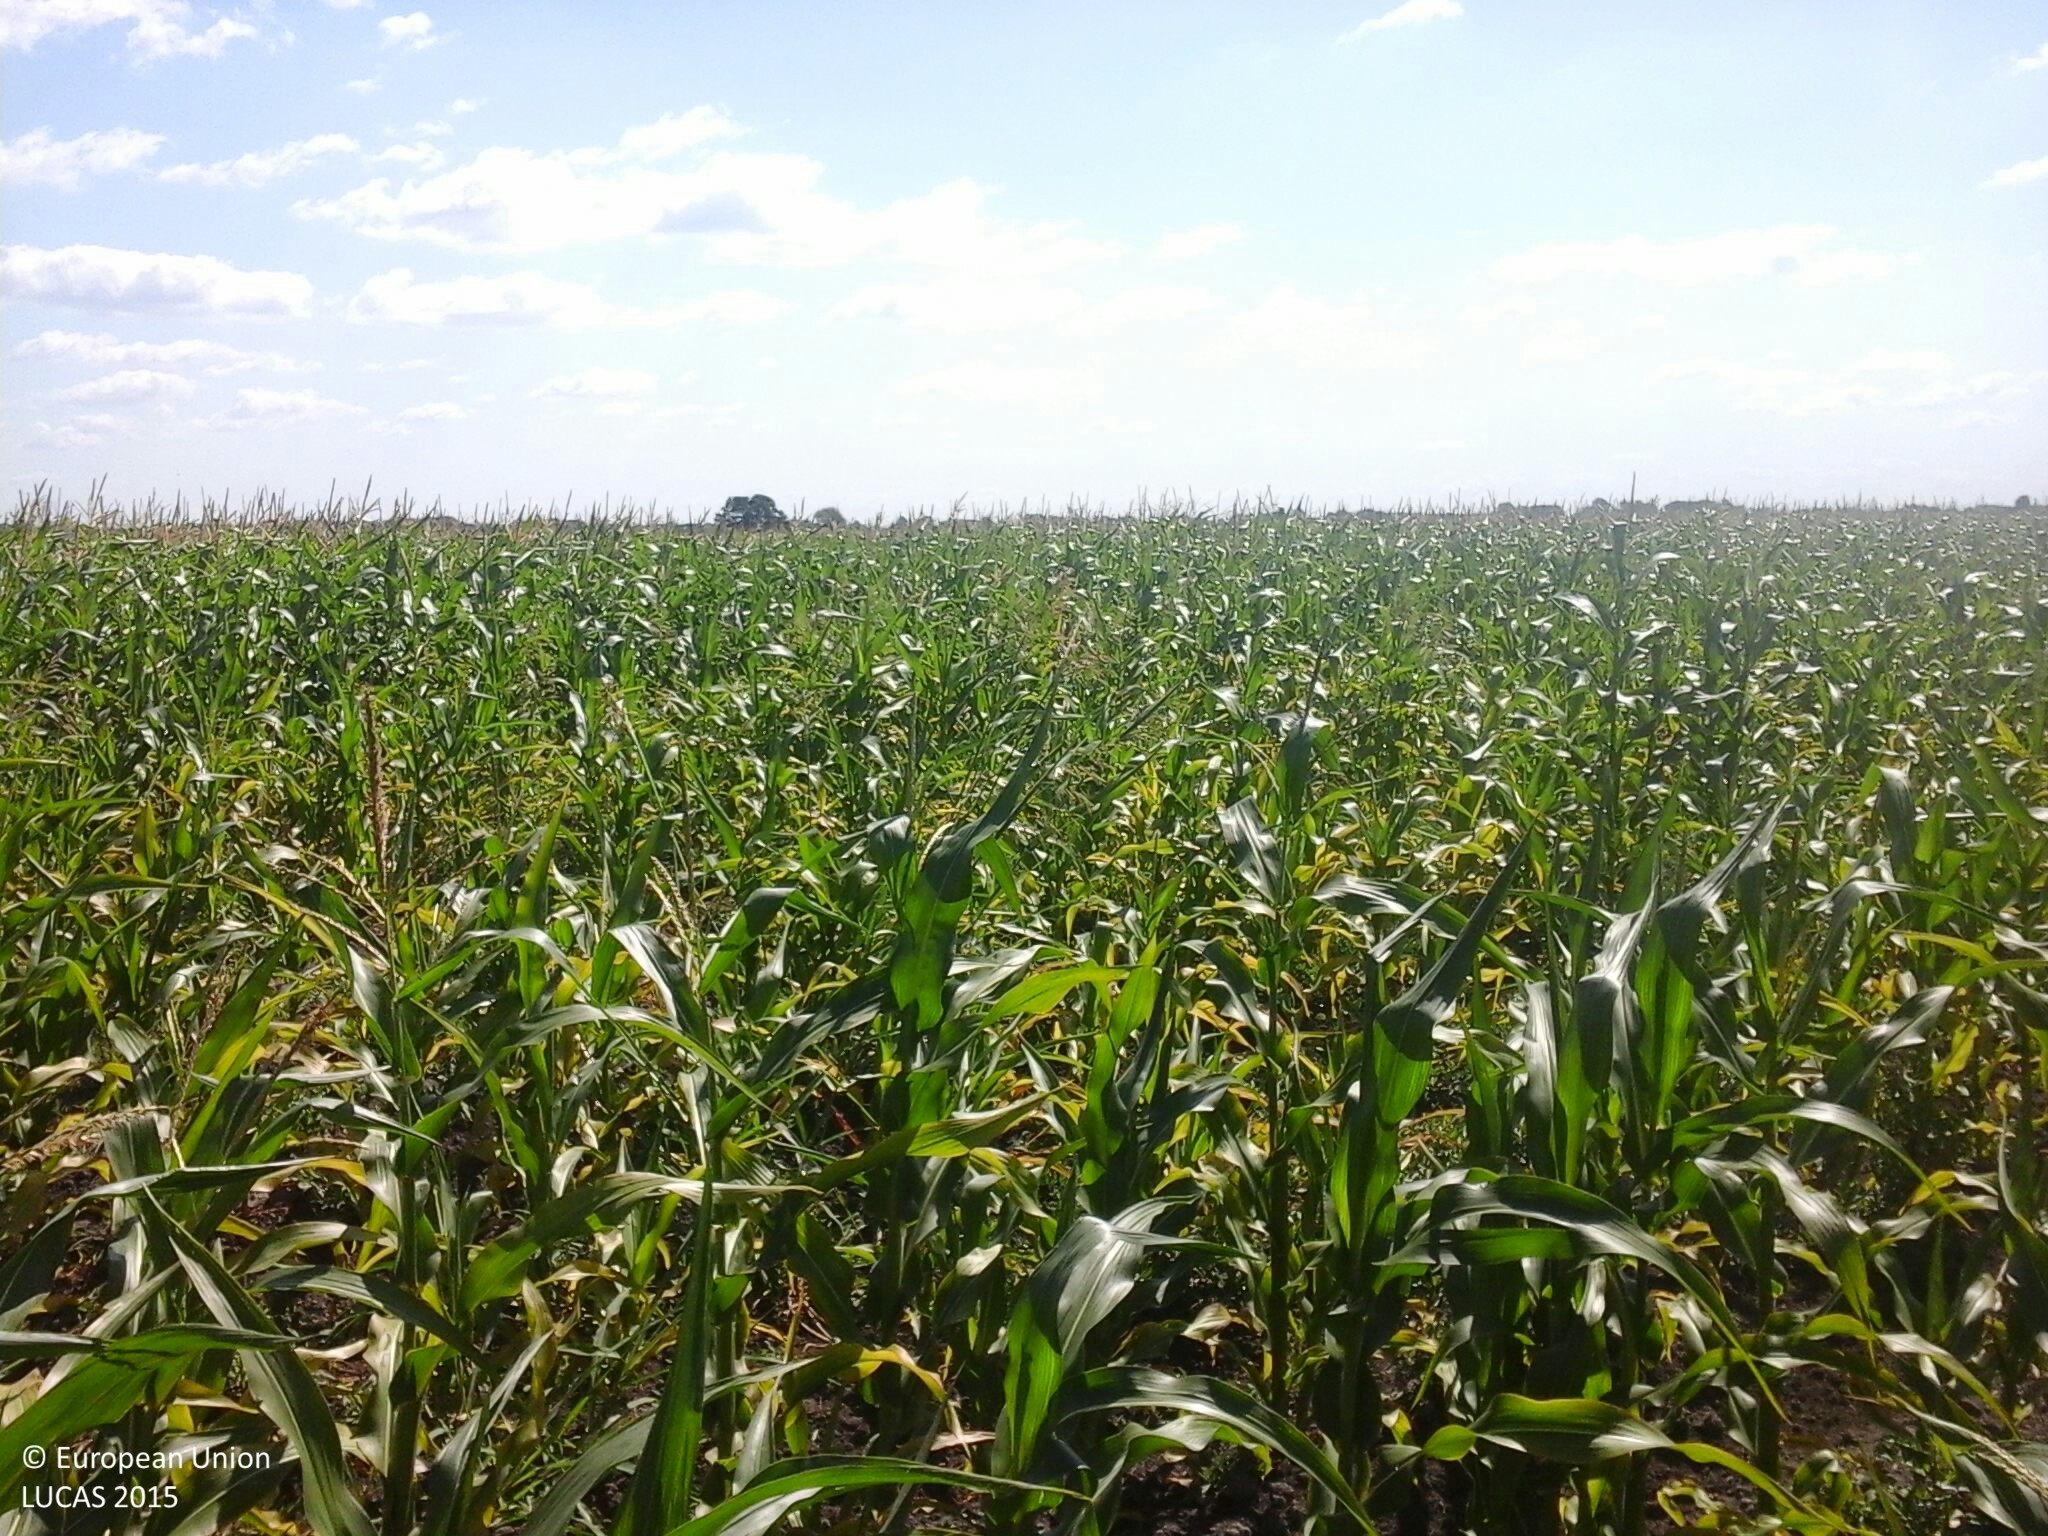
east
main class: Cropland
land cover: Maize
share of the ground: > 75 %
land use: Agriculture (excluding fallow land and kitchen gardens)
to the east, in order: Maize; Tracks; Oats; Temporary grasslands
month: July
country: HU
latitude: 47.2026
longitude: 19.2191
